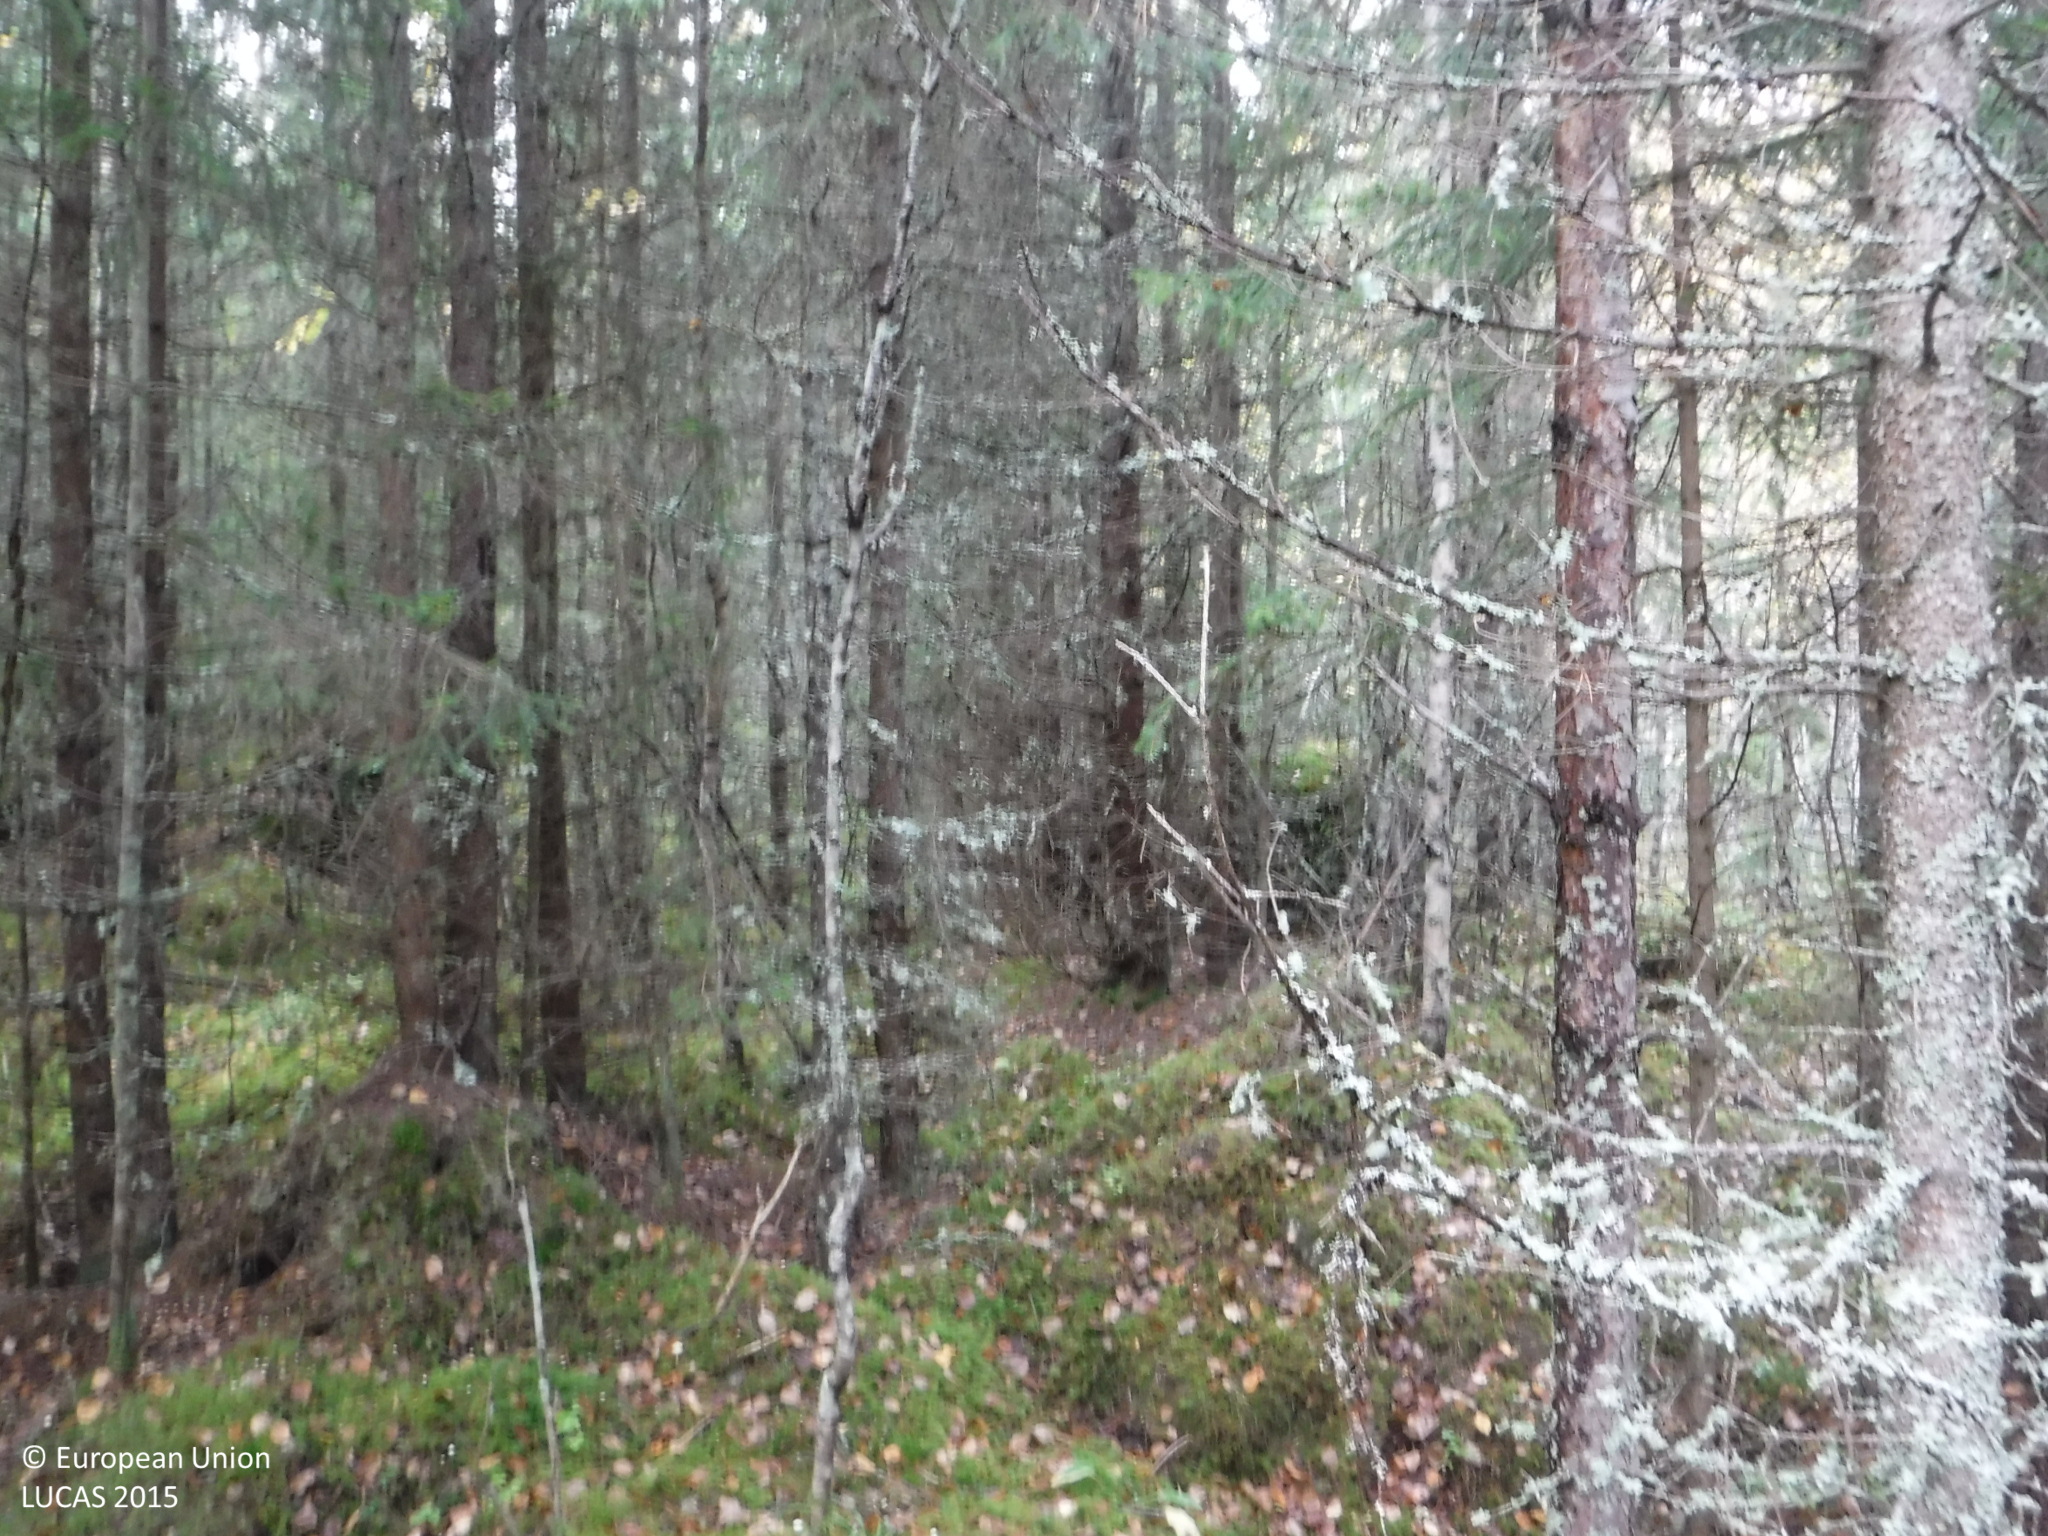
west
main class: Woodland
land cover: Spruce dominated mixed woodland
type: boreal forest
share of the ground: 50 - 75 %
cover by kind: coniferous forest trees 40 %, broadleaved forest trees 30 %, lichens and mosses 20 %, shrubs 10 %
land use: Forestry
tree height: > 5 m
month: September
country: FI
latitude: 61.8388
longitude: 24.2406
